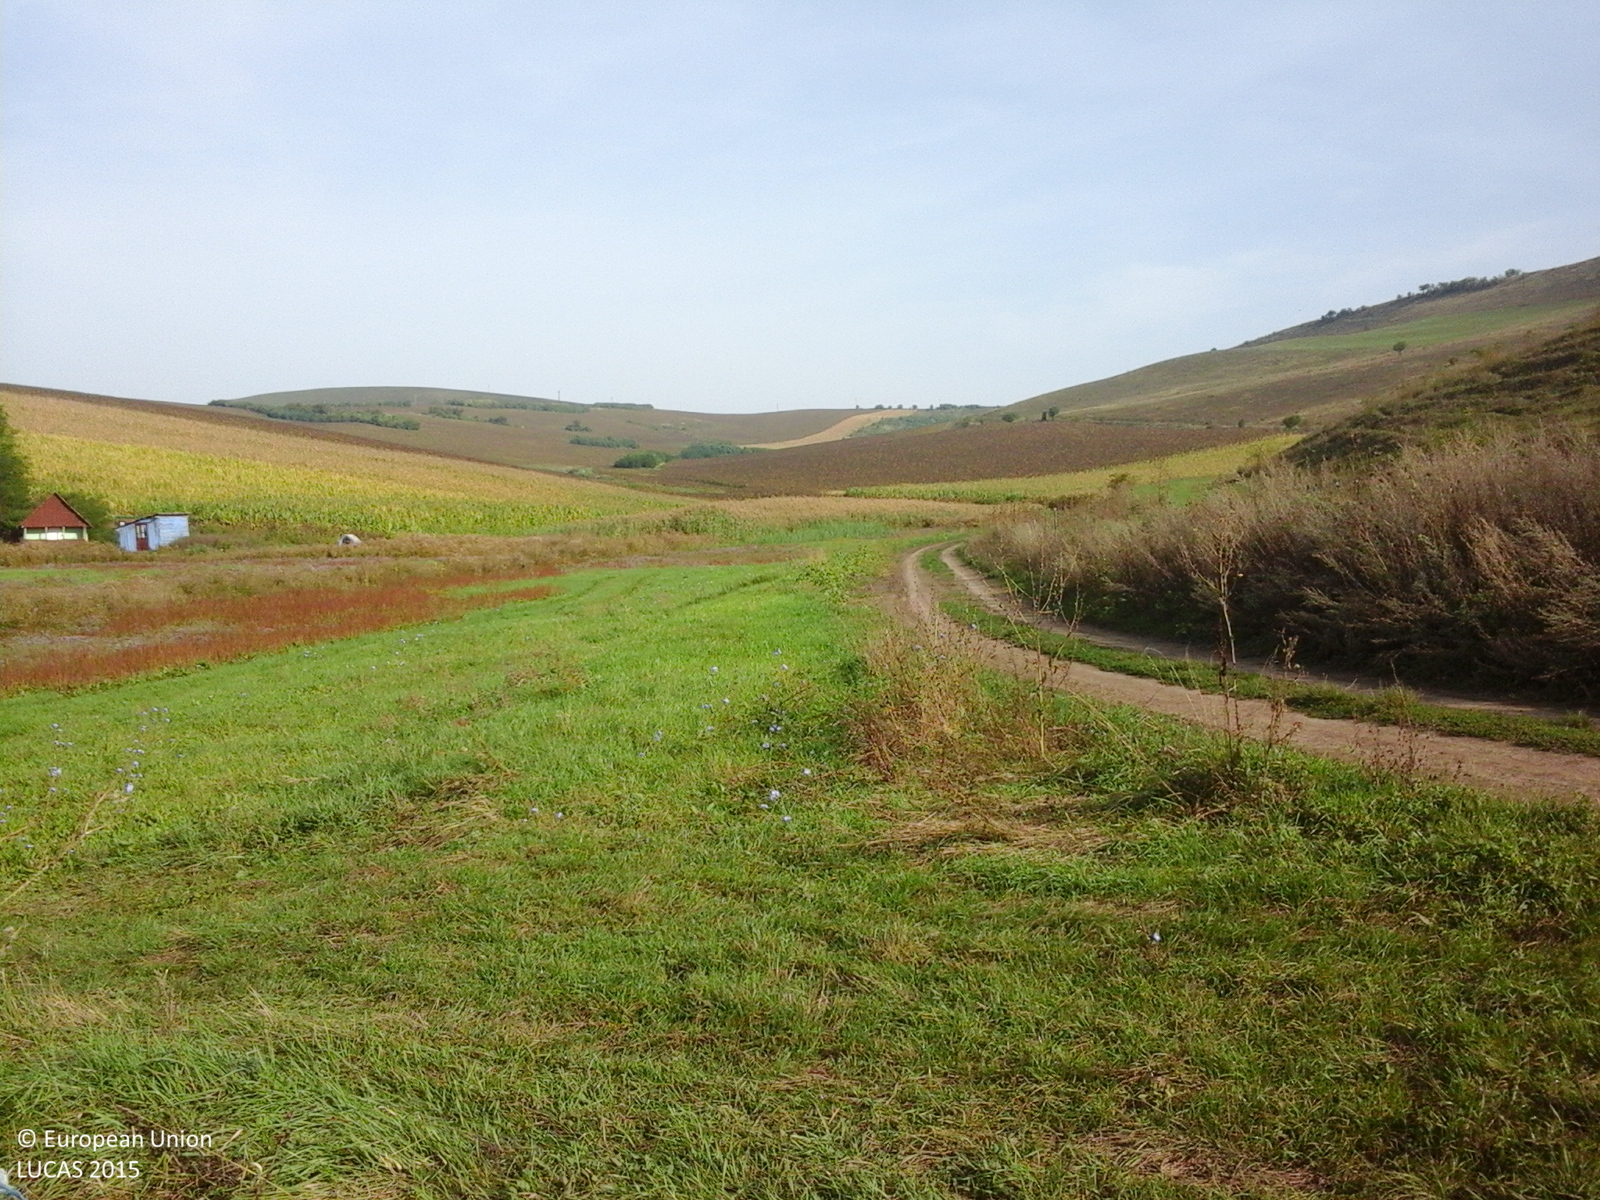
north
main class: Grassland
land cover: Grassland without tree/shrub cover
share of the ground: > 75 %
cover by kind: herbaceous plants 100 %
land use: Agriculture (excluding fallow land and kitchen gardens)
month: September
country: RO
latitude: 46.6523
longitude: 23.8340
